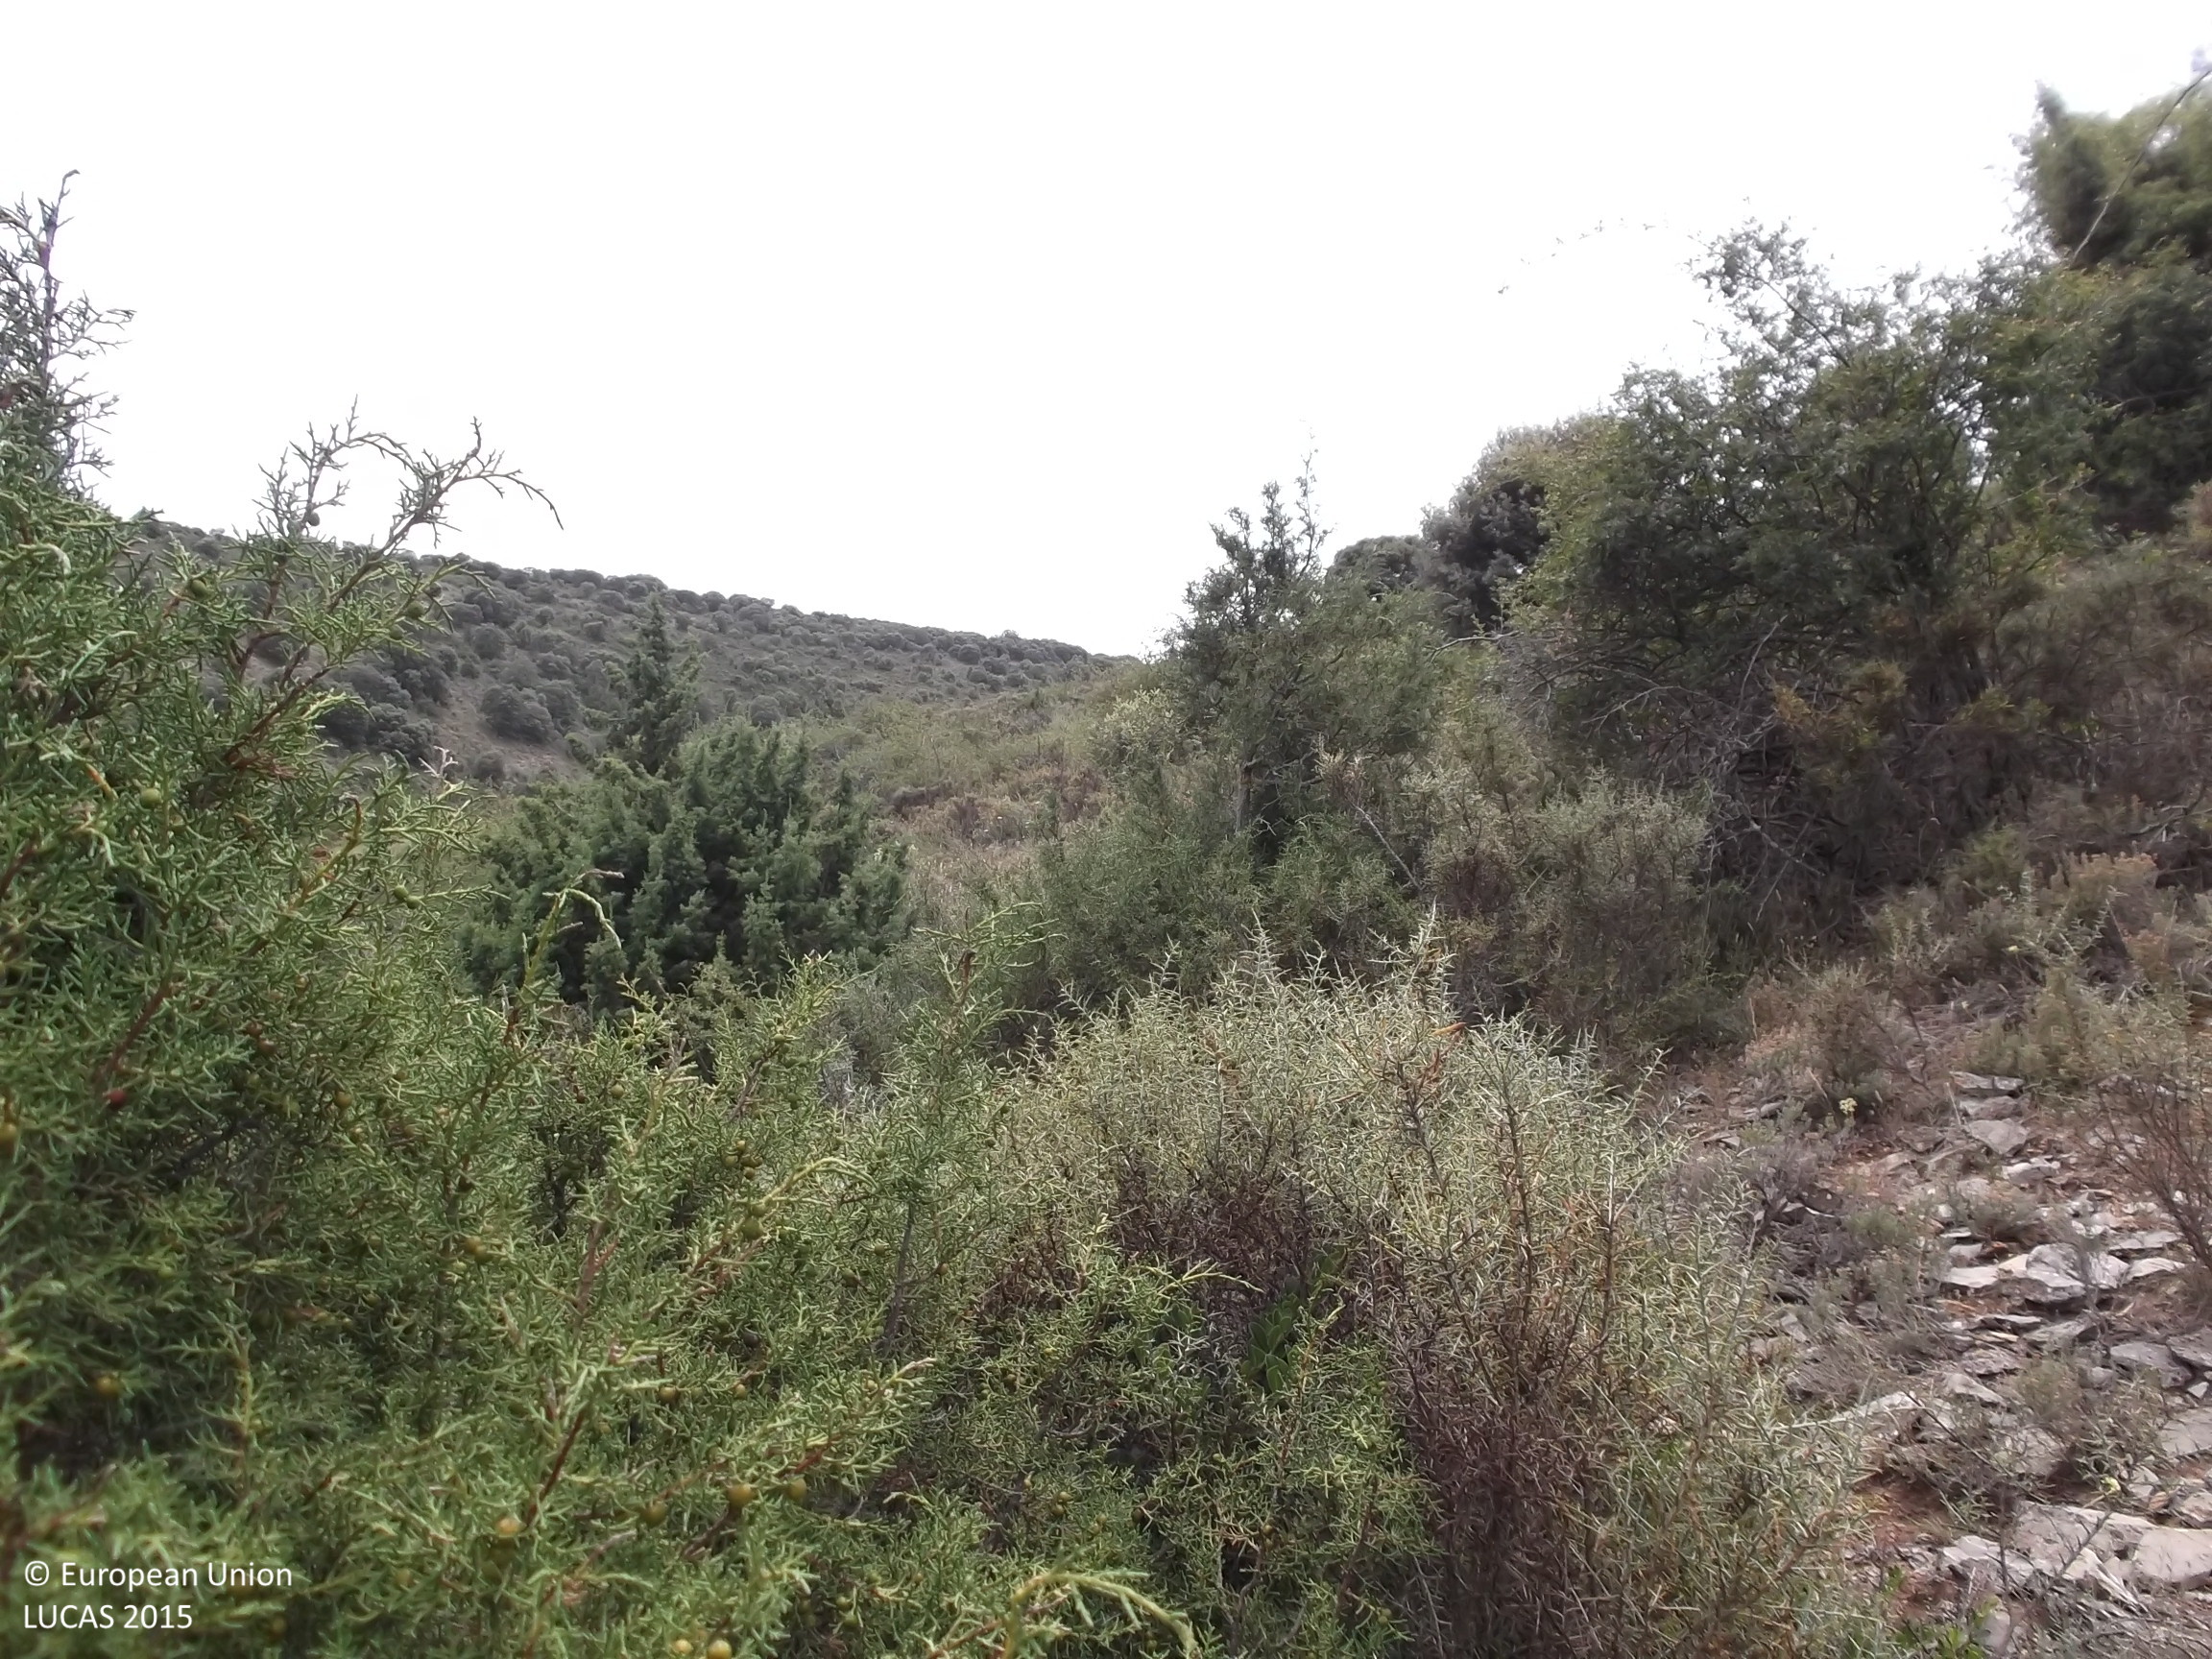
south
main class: Woodland
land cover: Other coniferous woodland
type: coniferous forest of the mediterranean region
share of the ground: 10 - 25 %
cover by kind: shrubs 70 %, coniferous forest trees 15 %, herbaceous plants 10 %, broadleaved forest trees 5 %
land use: Semi-natural and natural areas not in use
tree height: < 5 m
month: July
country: ES
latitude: 41.9038
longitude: -1.9802
